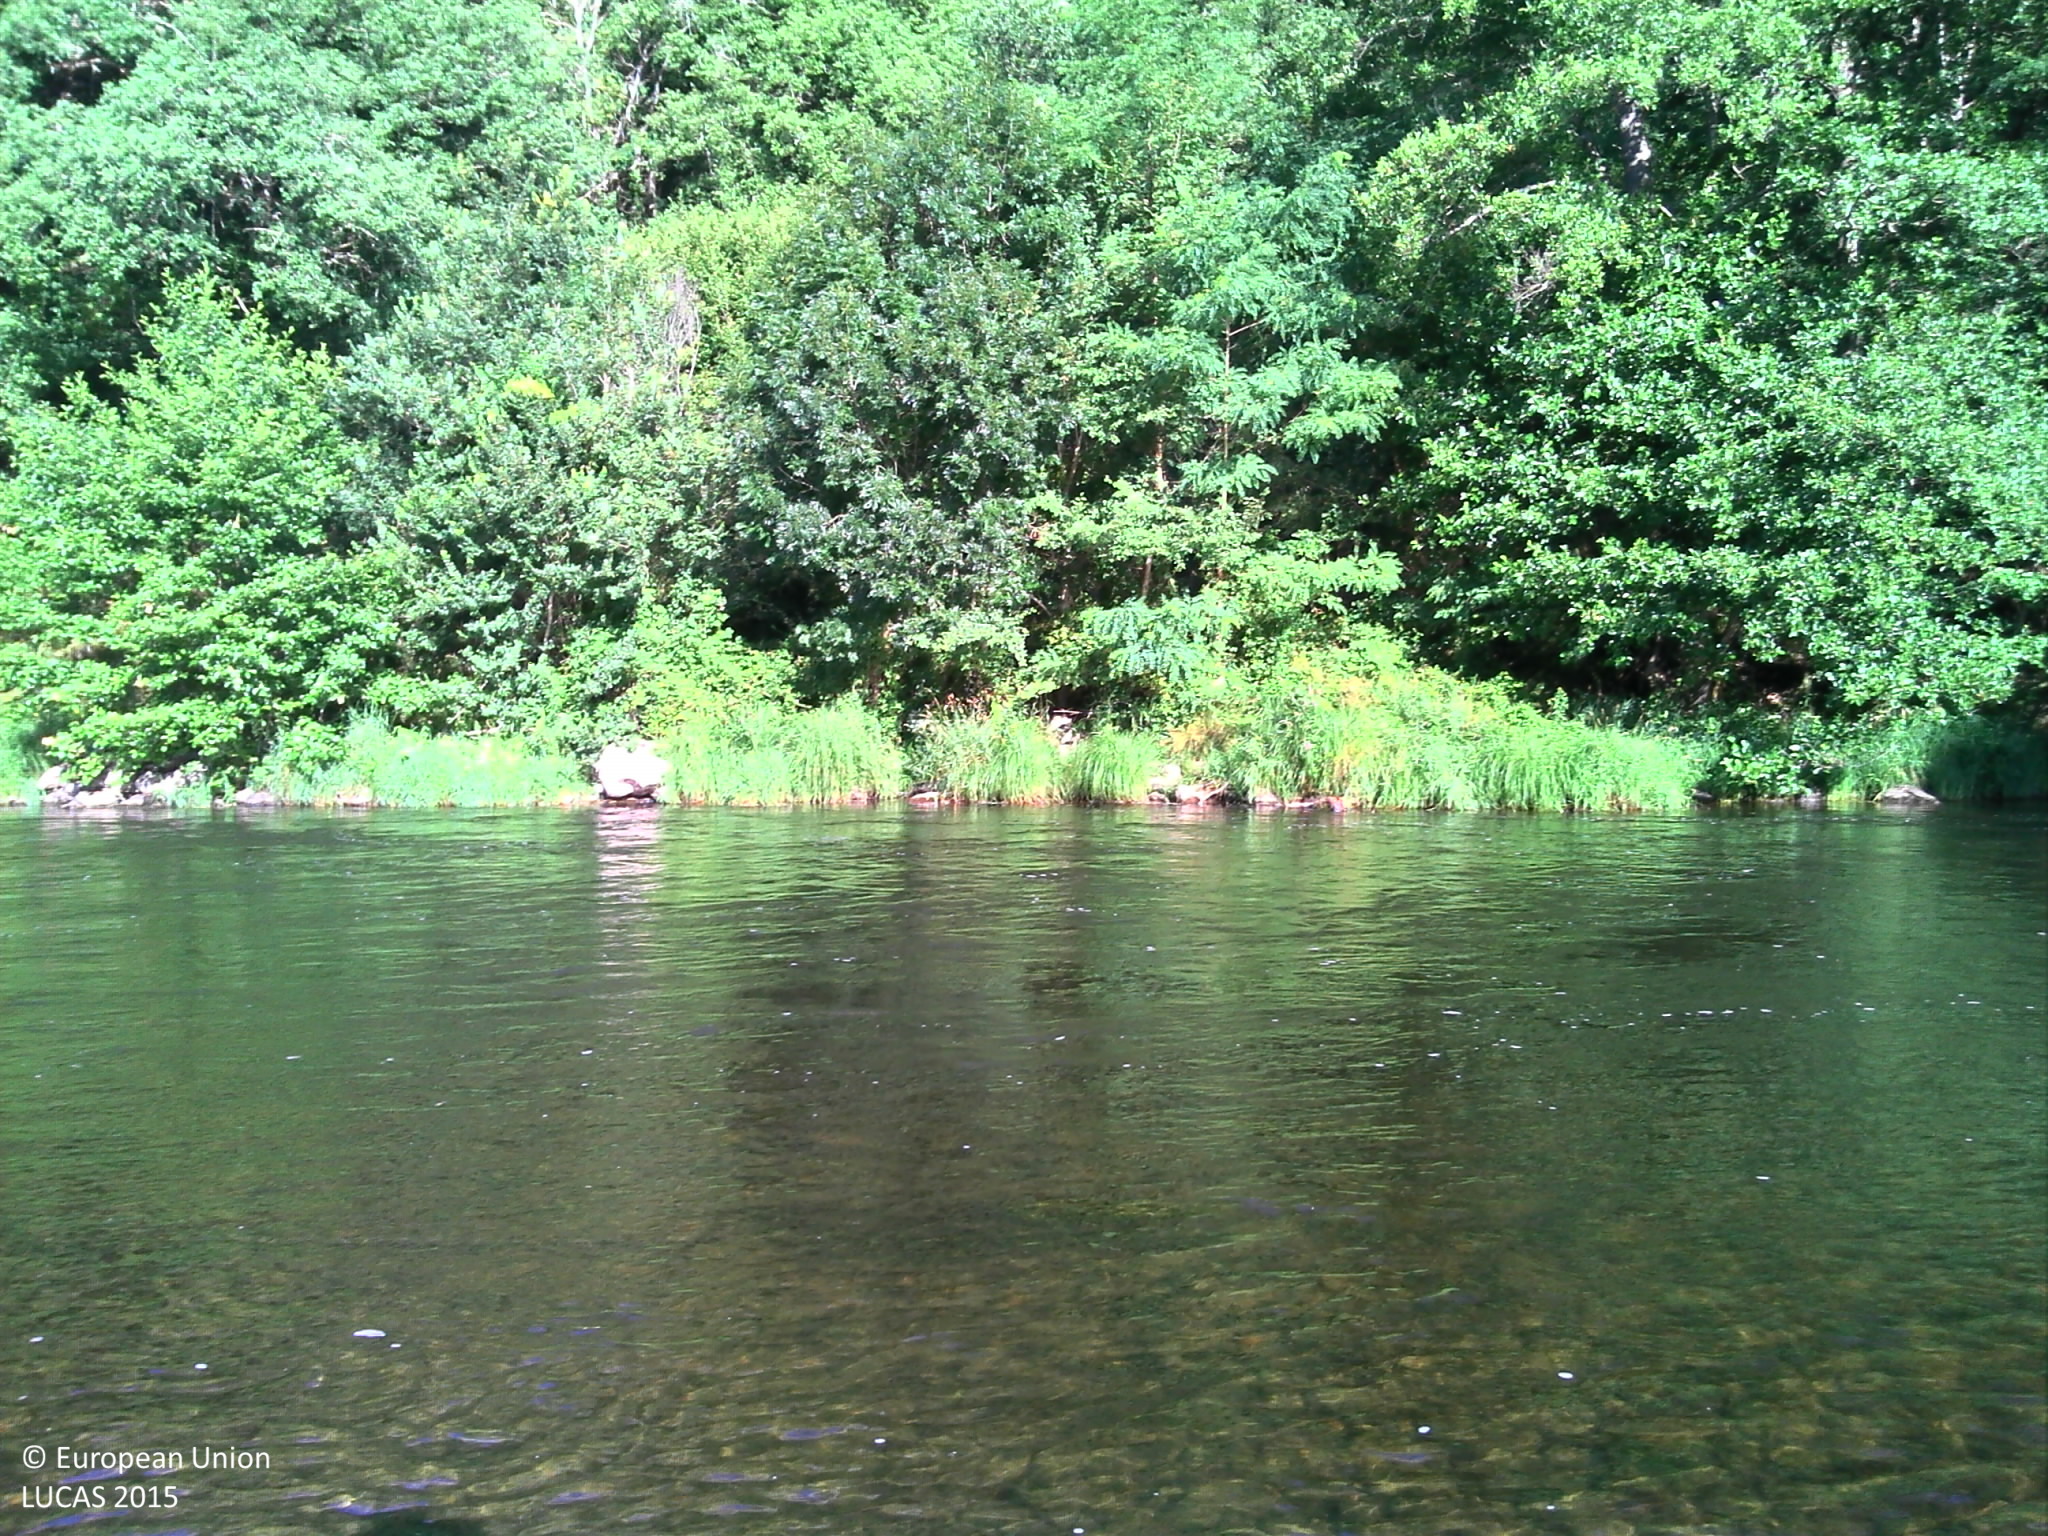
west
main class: Woodland
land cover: Broadleaved woodland
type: mesophytic deciduous forest
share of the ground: > 75 %
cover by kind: broadleaved forest trees 100 %
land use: Forestry
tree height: > 5 m
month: July
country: FR
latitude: 45.2250
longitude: 3.3926
